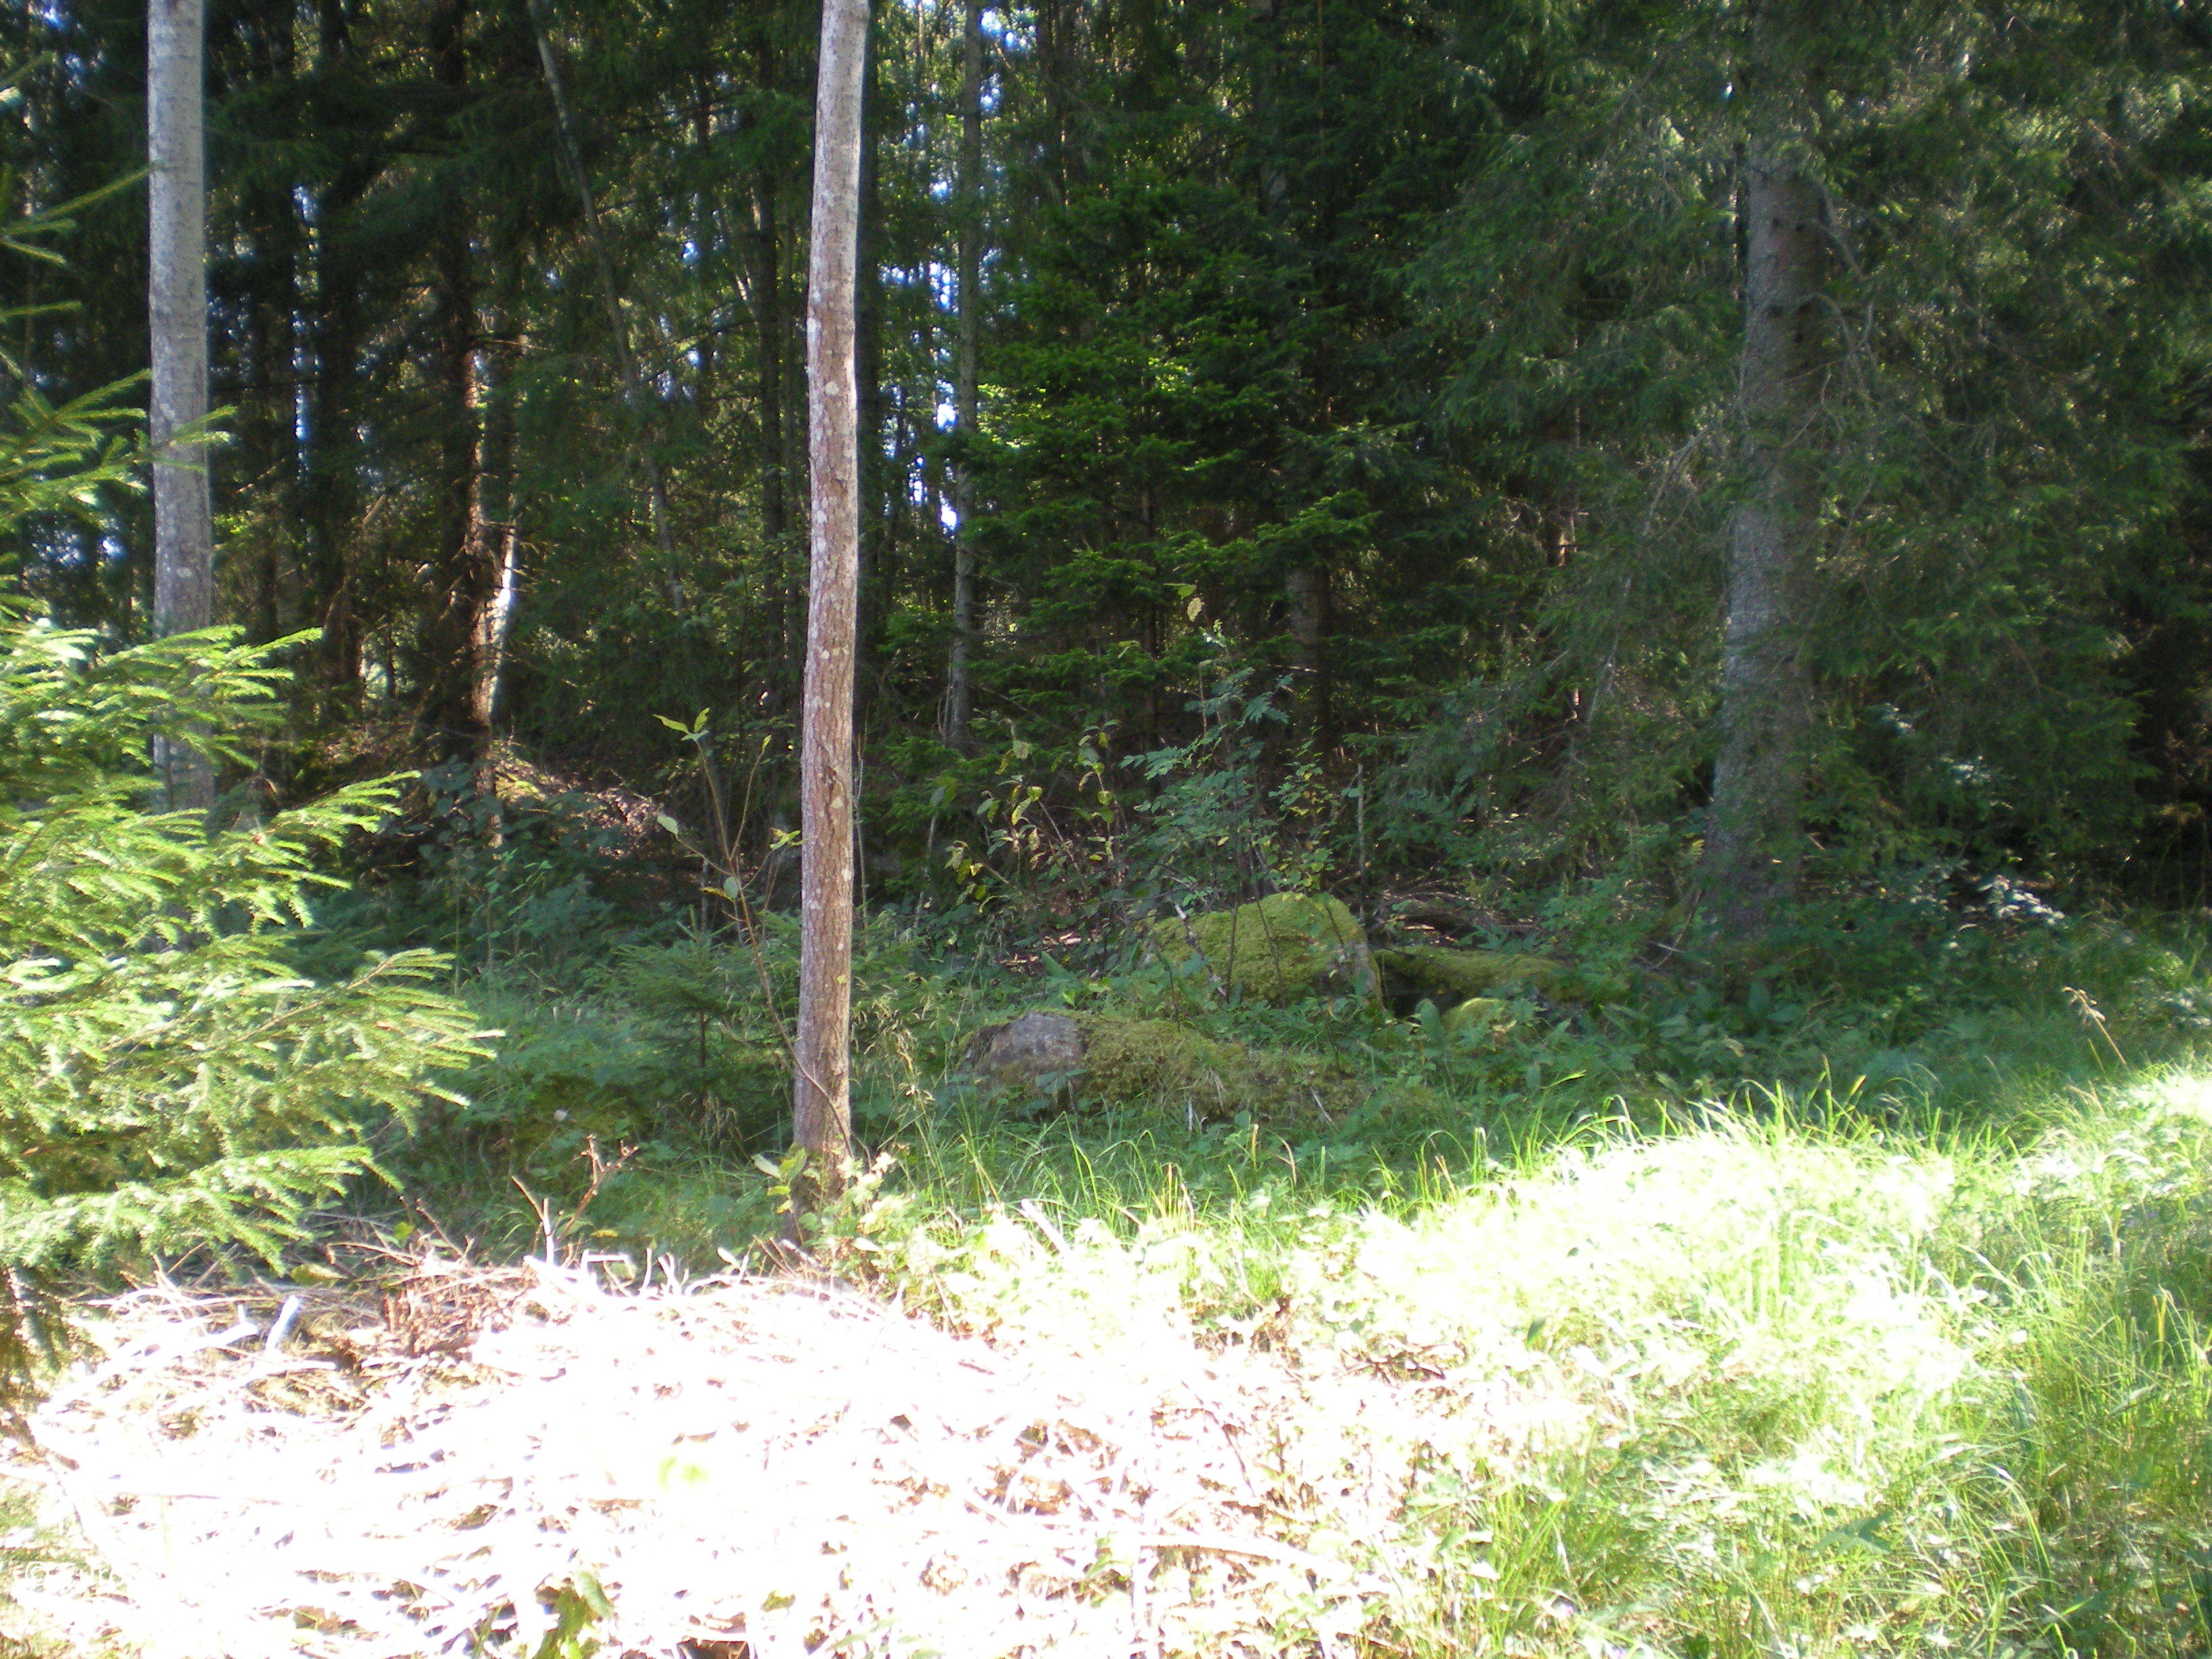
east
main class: Woodland
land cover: Broadleaved woodland
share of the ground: 25 - 50 %
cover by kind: broadleaved forest trees 40 %, herbaceous plants 40 %, coniferous forest trees 10 %, shrubs 5 %, lichens and mosses 5 %
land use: Forestry
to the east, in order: Broadleaved woodland; Spruce dominated mixed woodland; Grassland with sparse tree/shrub cover; Grassland without tree/shrub cover; Grassland with sparse tree/shrub cover; Fences; Electric lines; Grassland with sparse tree/shrub cover; Electric lines; Grassland with sparse tree/shrub cover; Fences; Ditches and canals; Fences; Broadleaved woodland; Grassland without tree/shrub cover; Broadleaved woodland
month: August
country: SE
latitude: 60.6201
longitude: 17.3906
